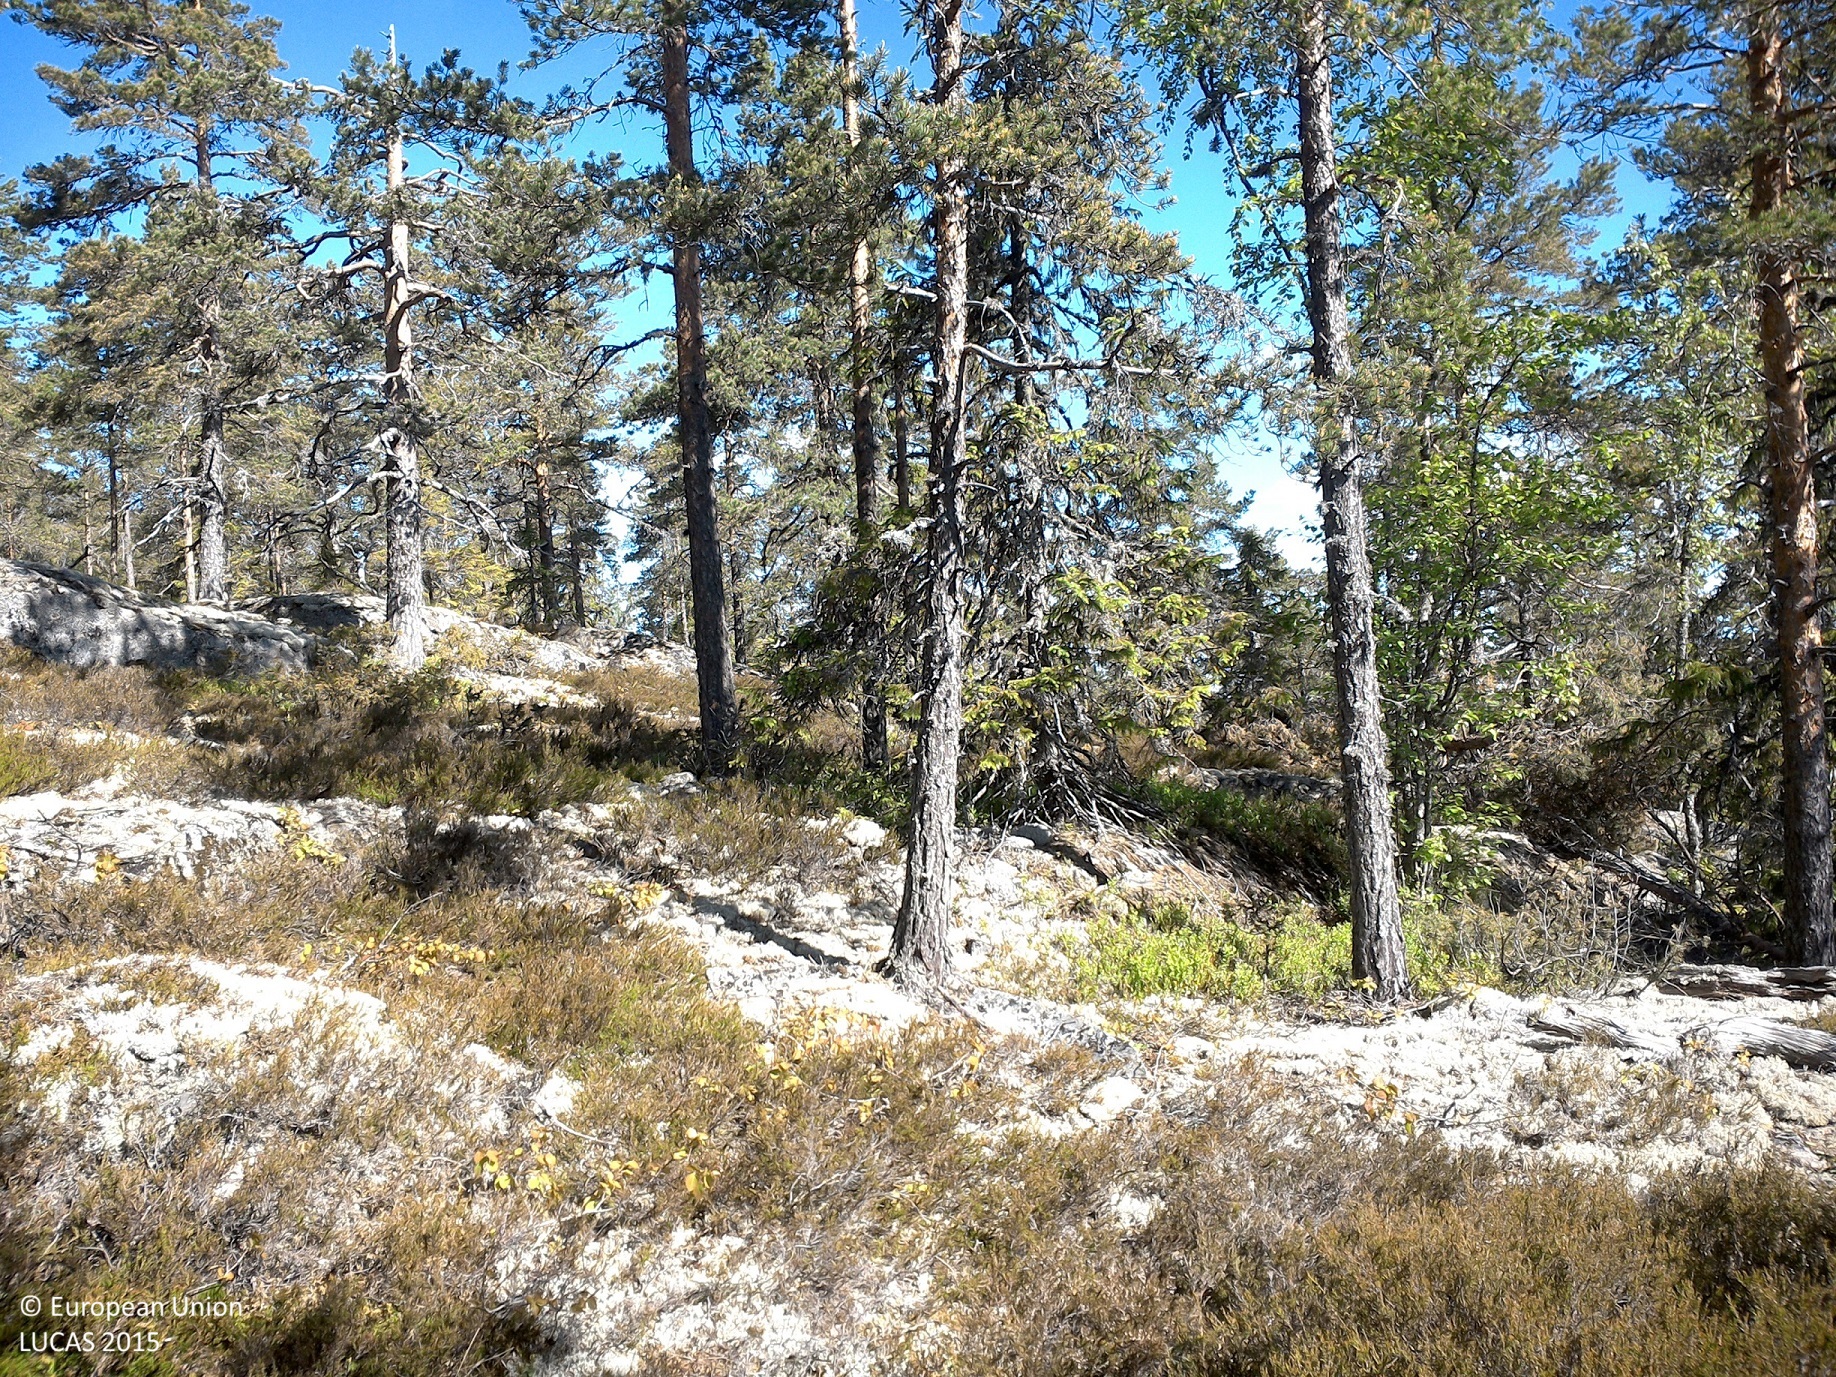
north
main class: Woodland
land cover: Pine dominated coniferous woodland
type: boreal forest
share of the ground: 10 - 25 %
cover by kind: shrubs 70 %, coniferous forest trees 20 %, lichens and mosses 10 %
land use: Forestry
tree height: > 5 m
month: June
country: SE
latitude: 62.6834
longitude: 17.7731
